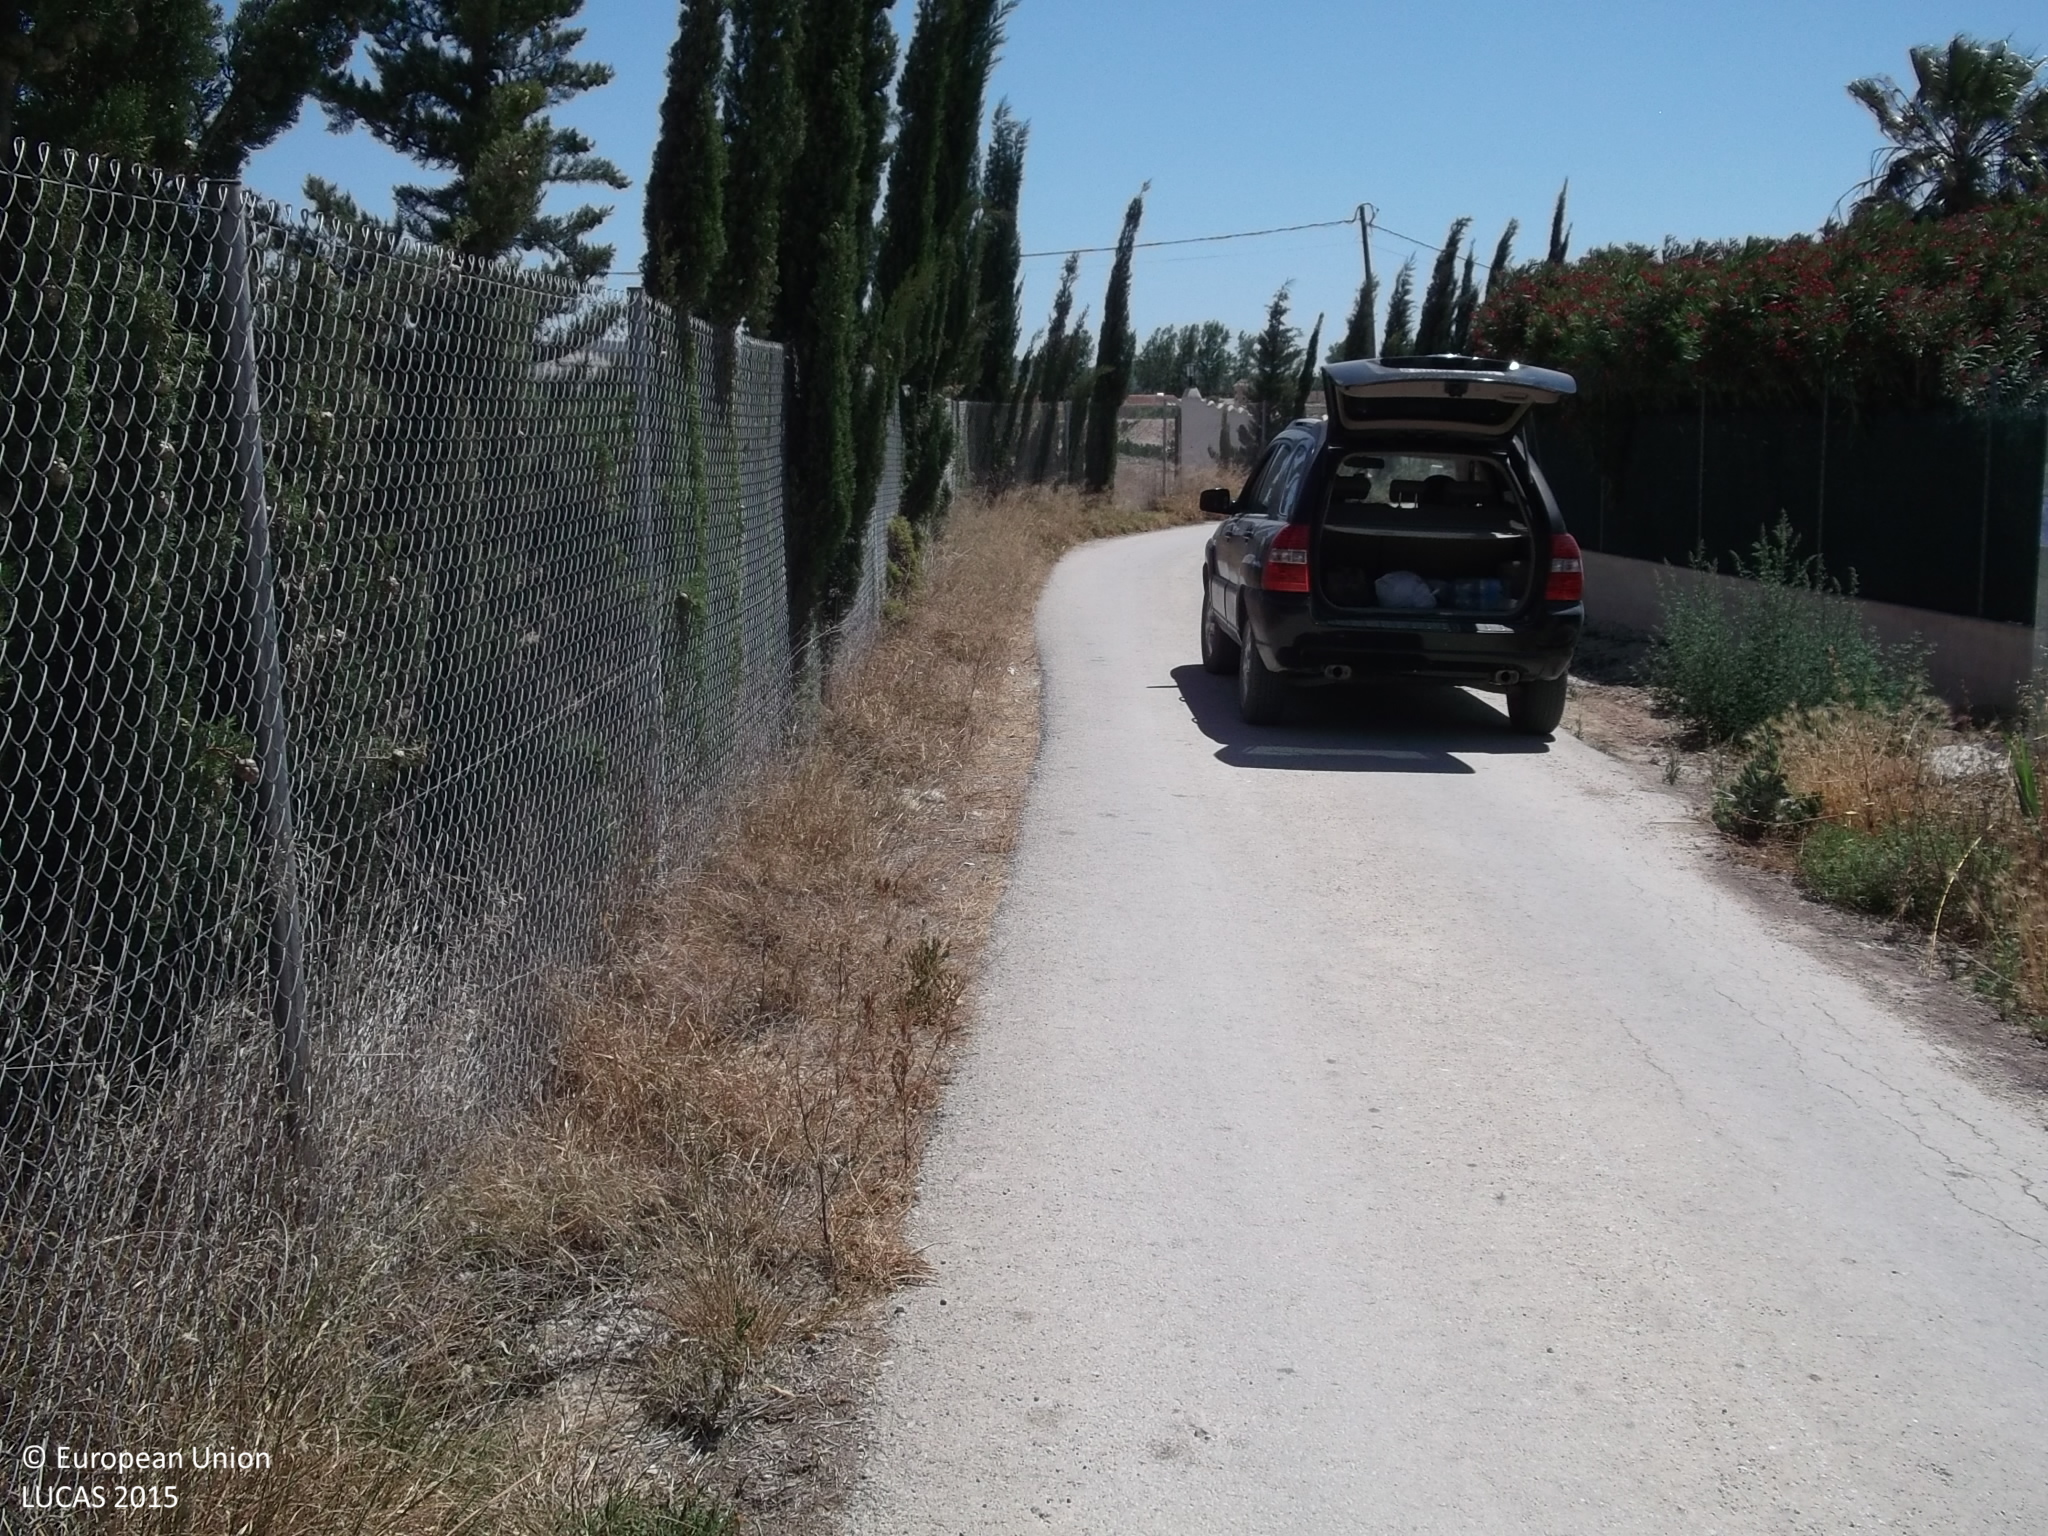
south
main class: Cropland
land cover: Oranges
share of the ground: < 10 %
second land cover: Spontaneously vegetated surfaces
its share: 25 - 50 %
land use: Agriculture (excluding fallow land and kitchen gardens)
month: May
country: ES
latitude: 38.0962
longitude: -0.8280
